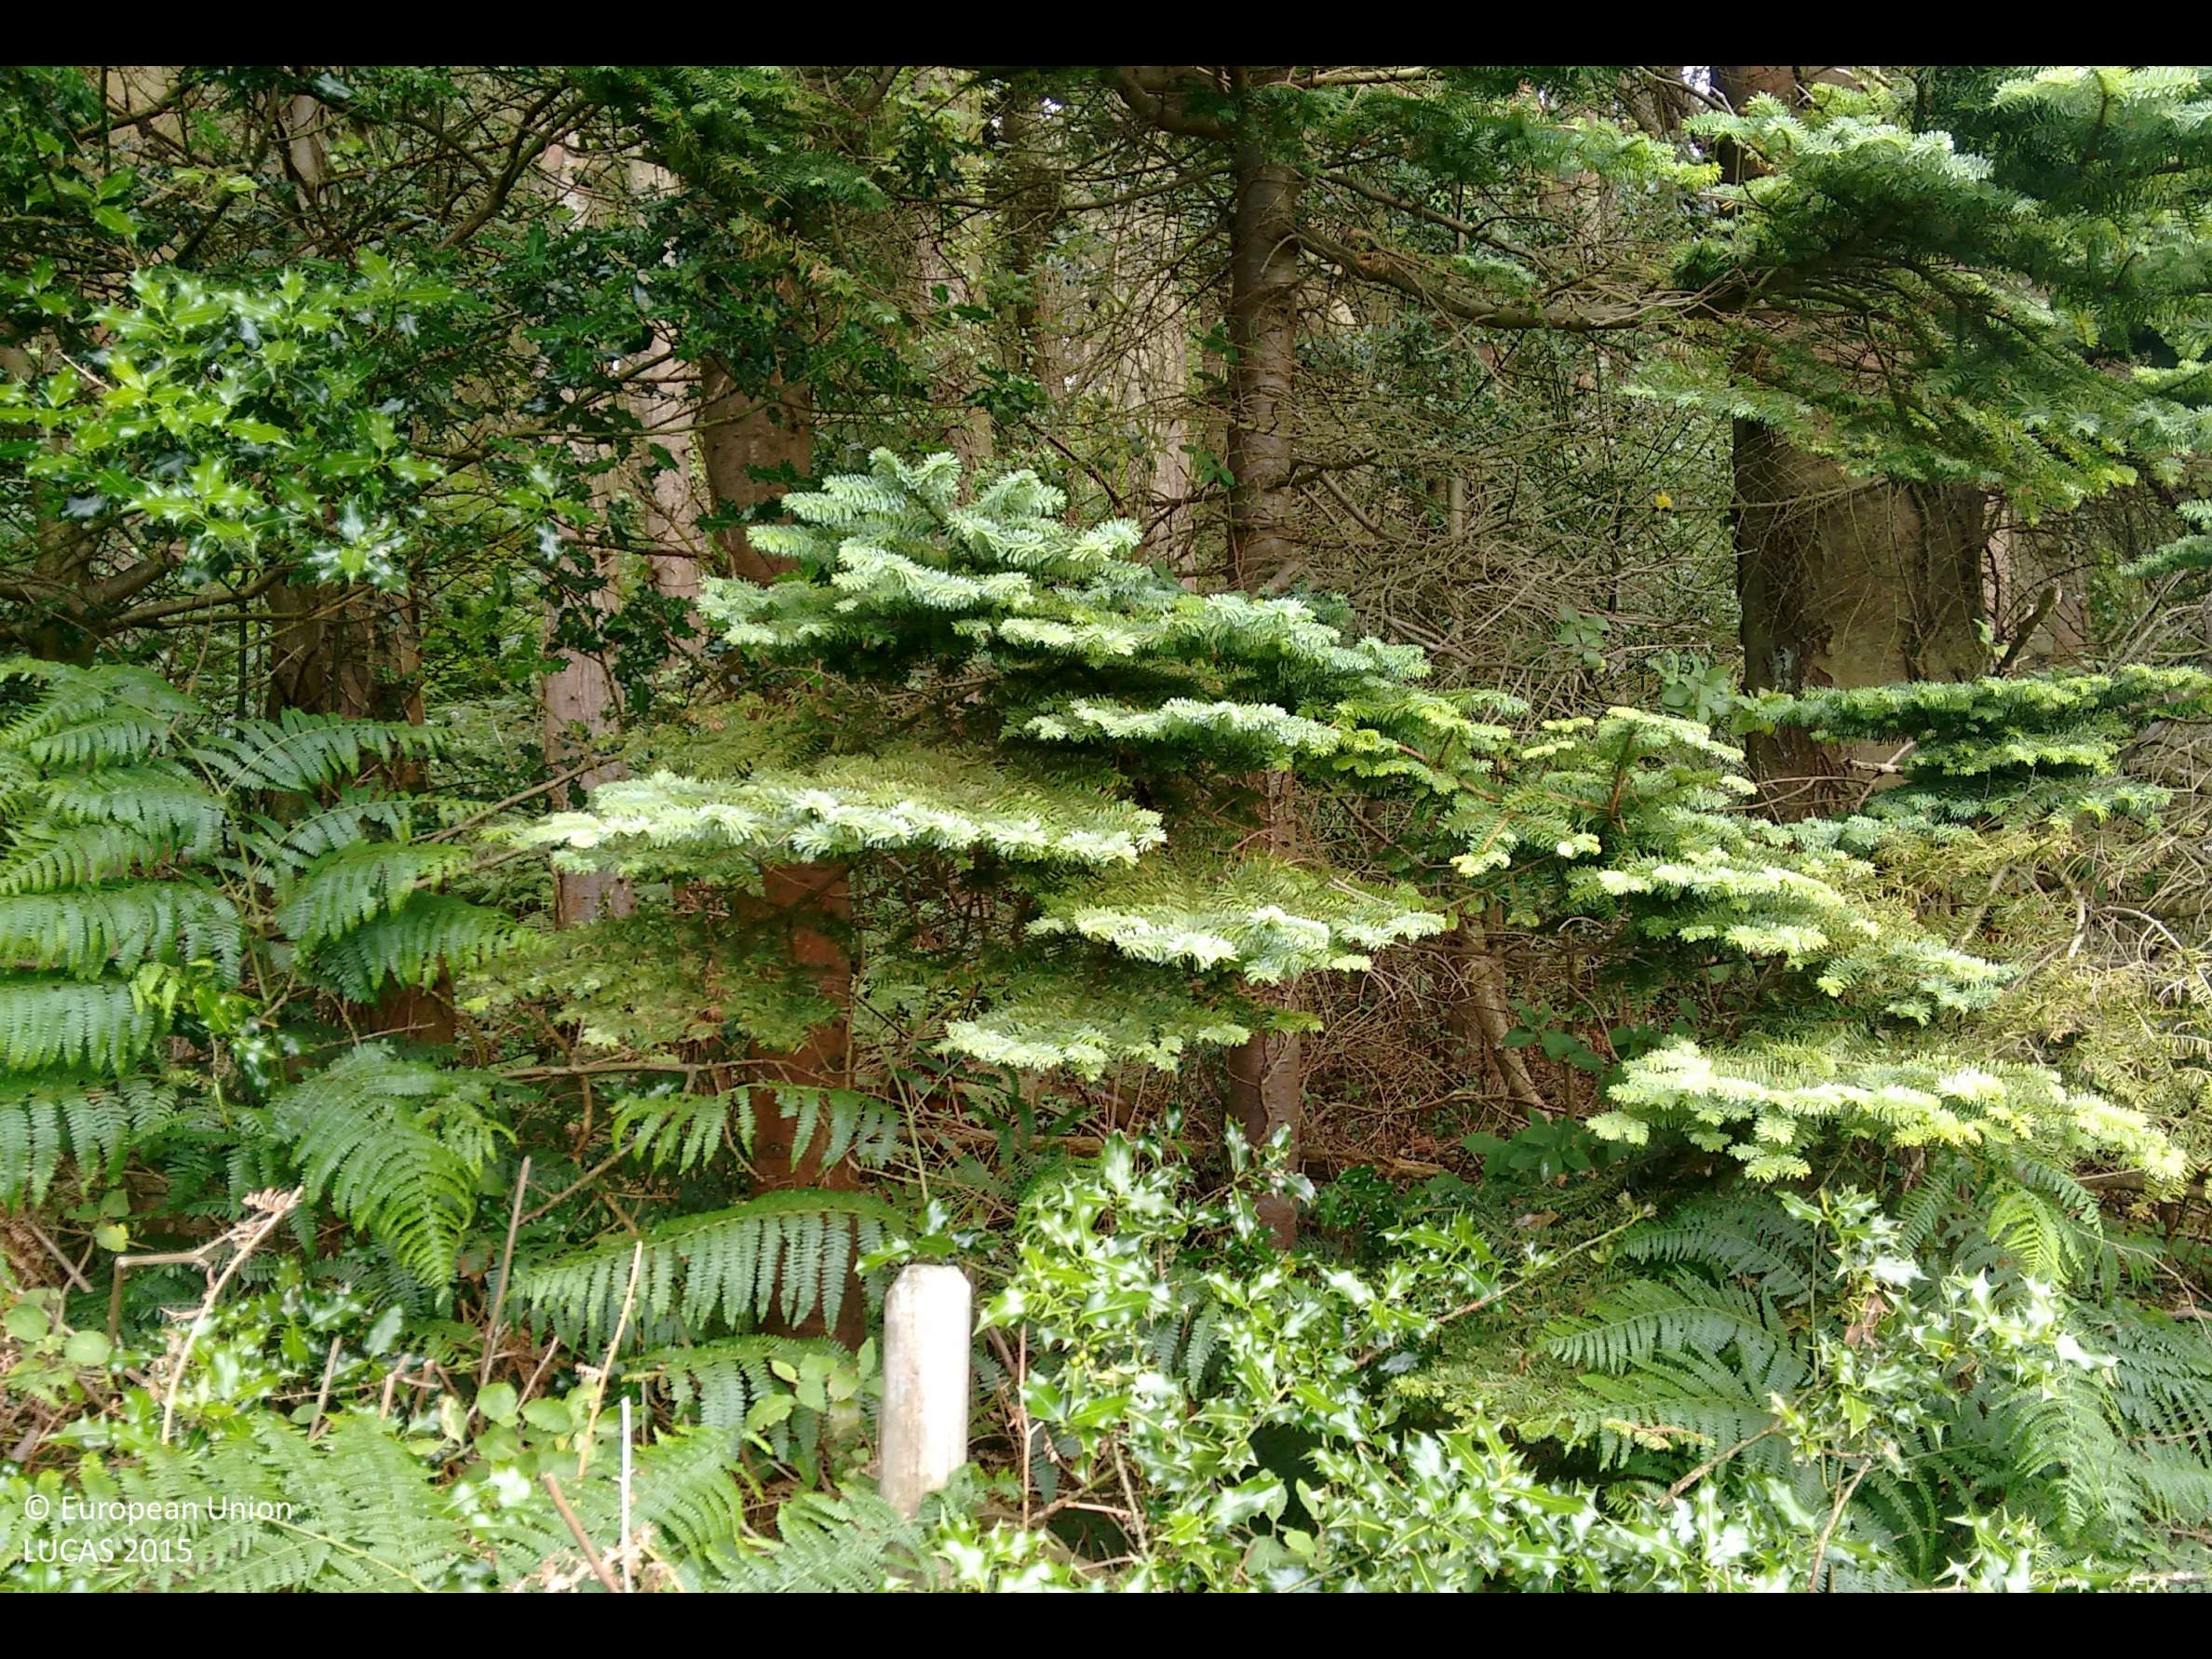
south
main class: Woodland
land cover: Other coniferous woodland
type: exotic forest
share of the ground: > 75 %
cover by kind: coniferous forest trees 100 %
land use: Forestry
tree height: > 5 m
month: August
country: GB
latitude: 53.2919
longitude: -4.1849
